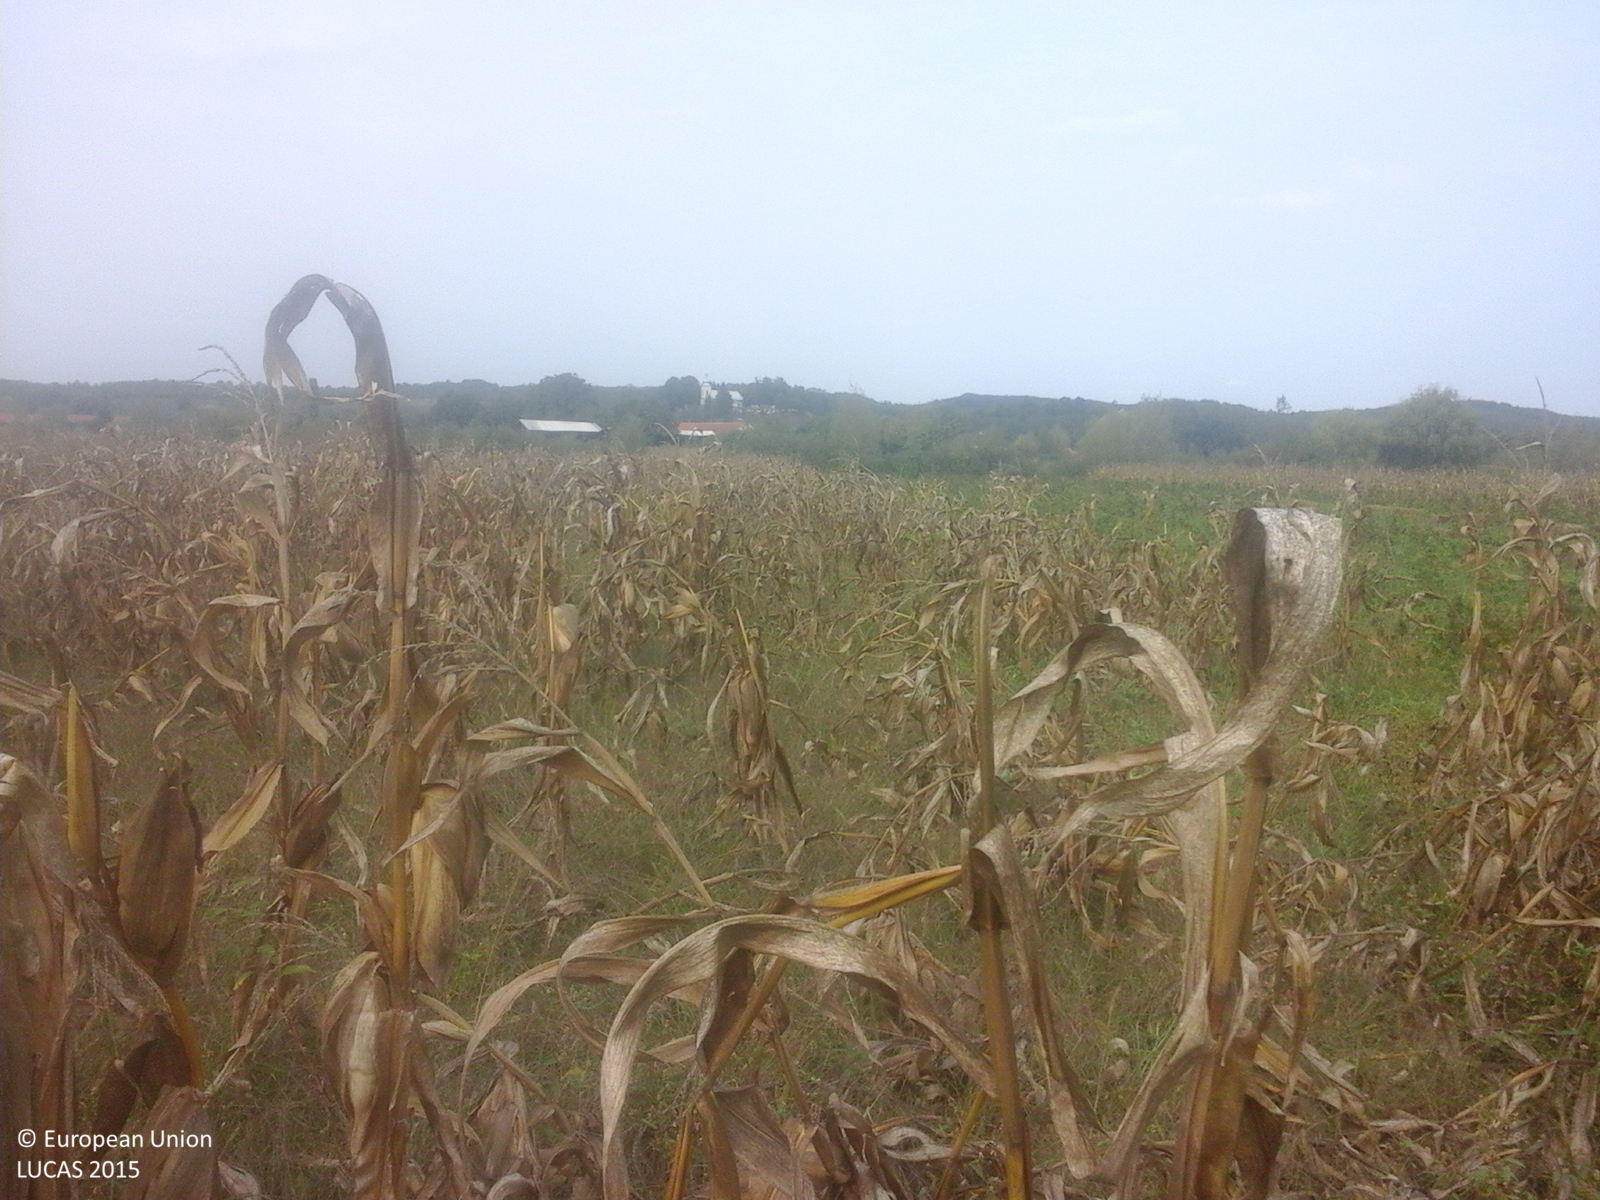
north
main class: Cropland
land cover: Maize
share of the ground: > 75 %
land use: Agriculture (excluding fallow land and kitchen gardens)
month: September
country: RO
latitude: 45.8665
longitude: 22.2167
